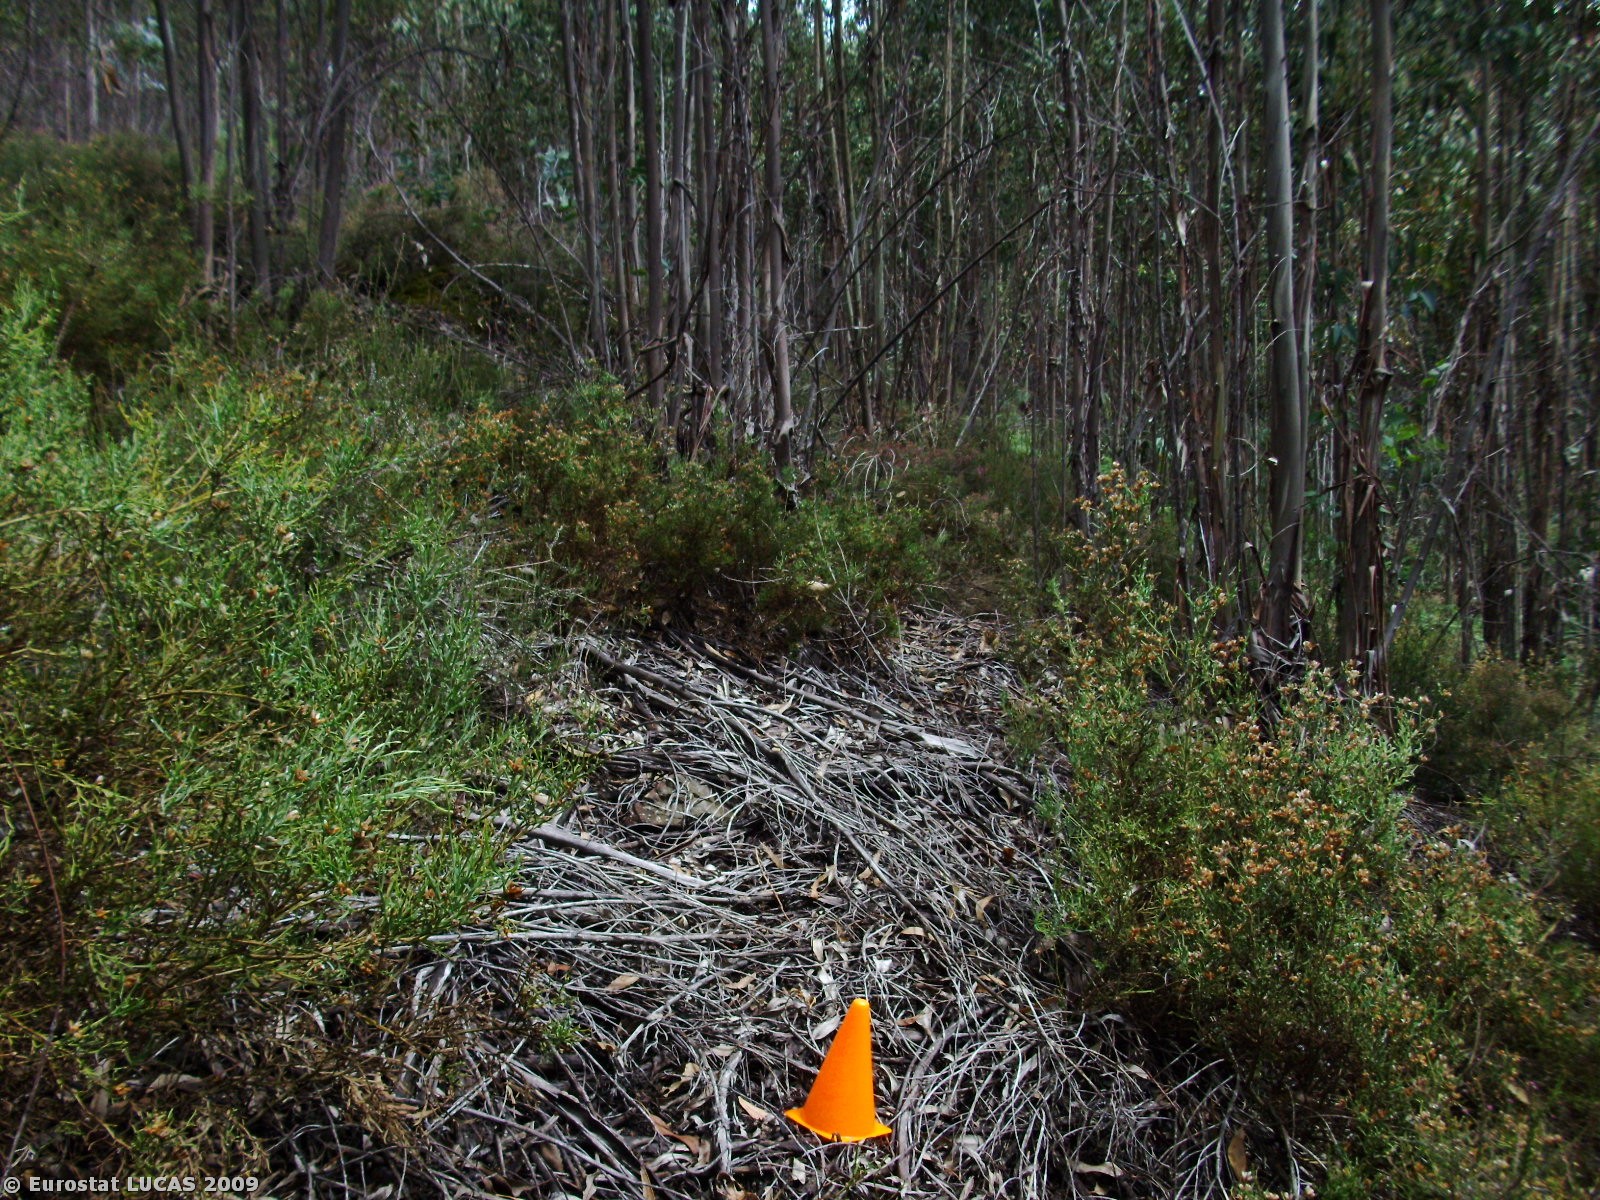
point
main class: Woodland
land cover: Broadleaved woodland
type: plantations and self-sown exotic forest
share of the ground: > 75 %
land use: Forestry
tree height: > 5 m
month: June
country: PT
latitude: 39.9663
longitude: -8.2322
